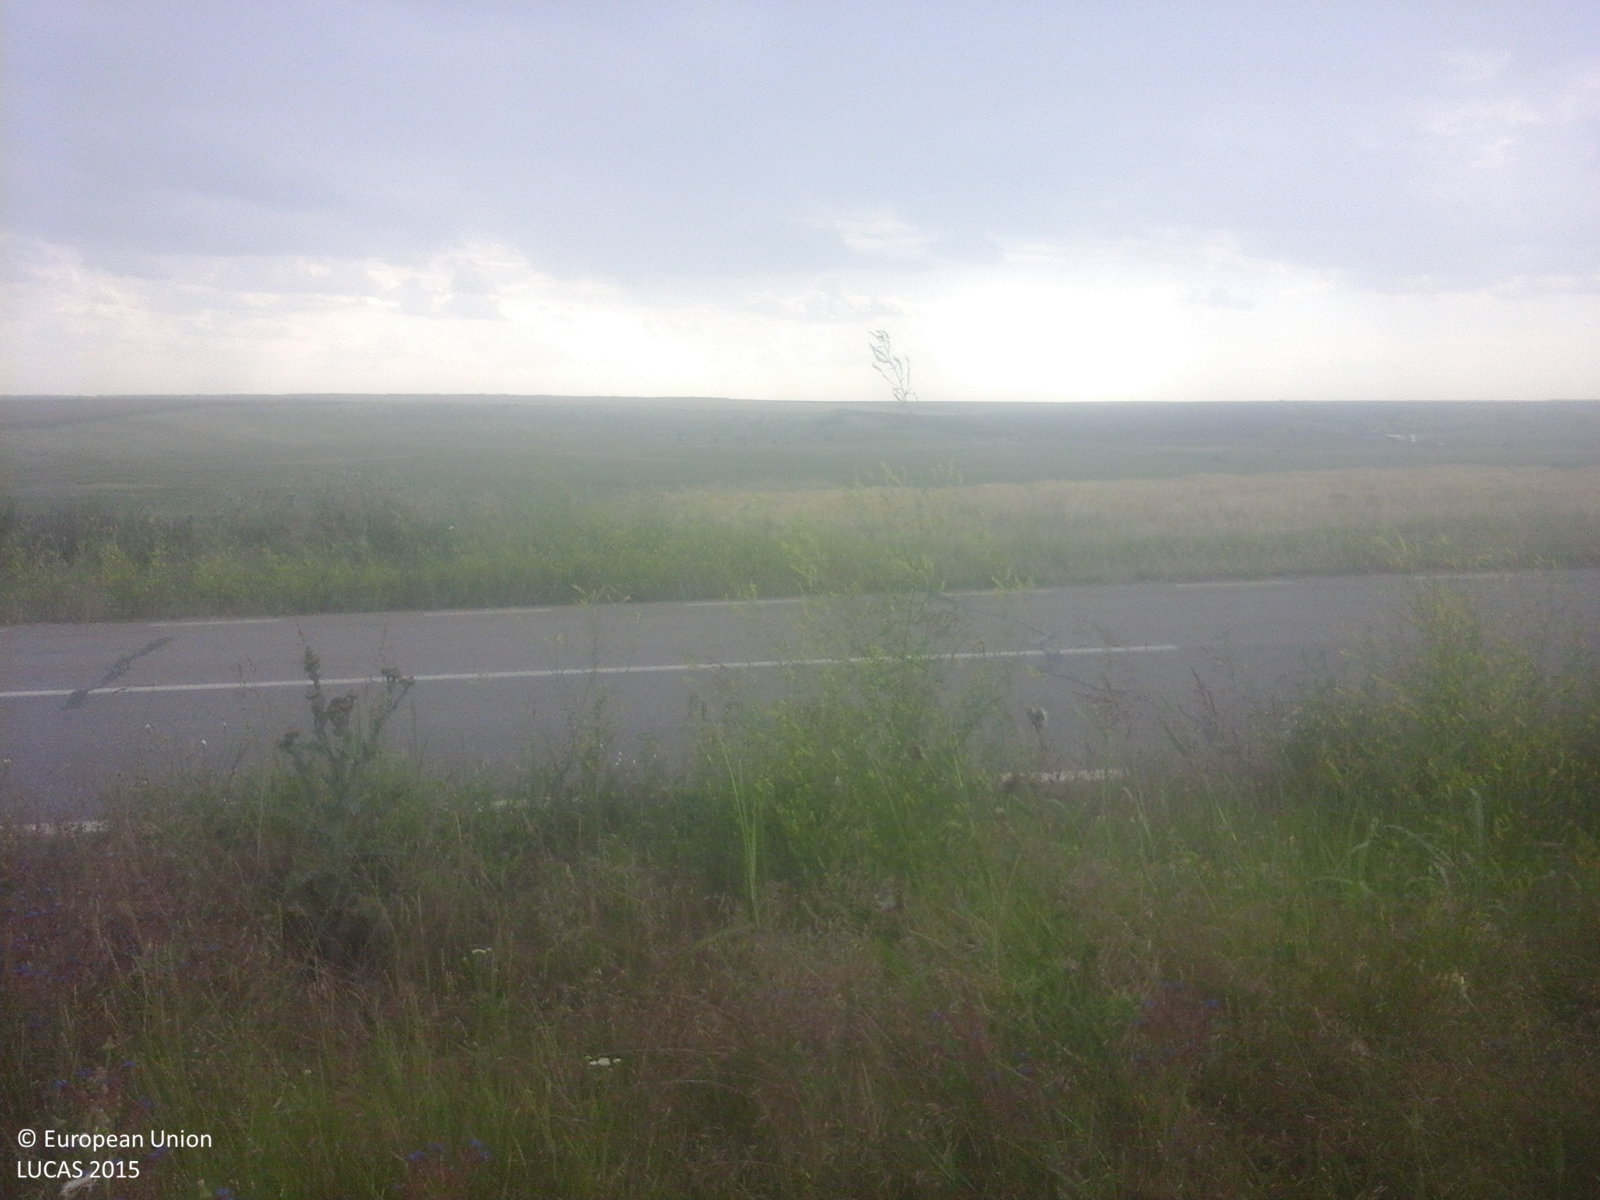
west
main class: Cropland
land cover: Sunflower
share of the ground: > 75 %
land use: Agriculture (excluding fallow land and kitchen gardens)
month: July
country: RO
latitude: 44.0896
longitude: 25.4106
